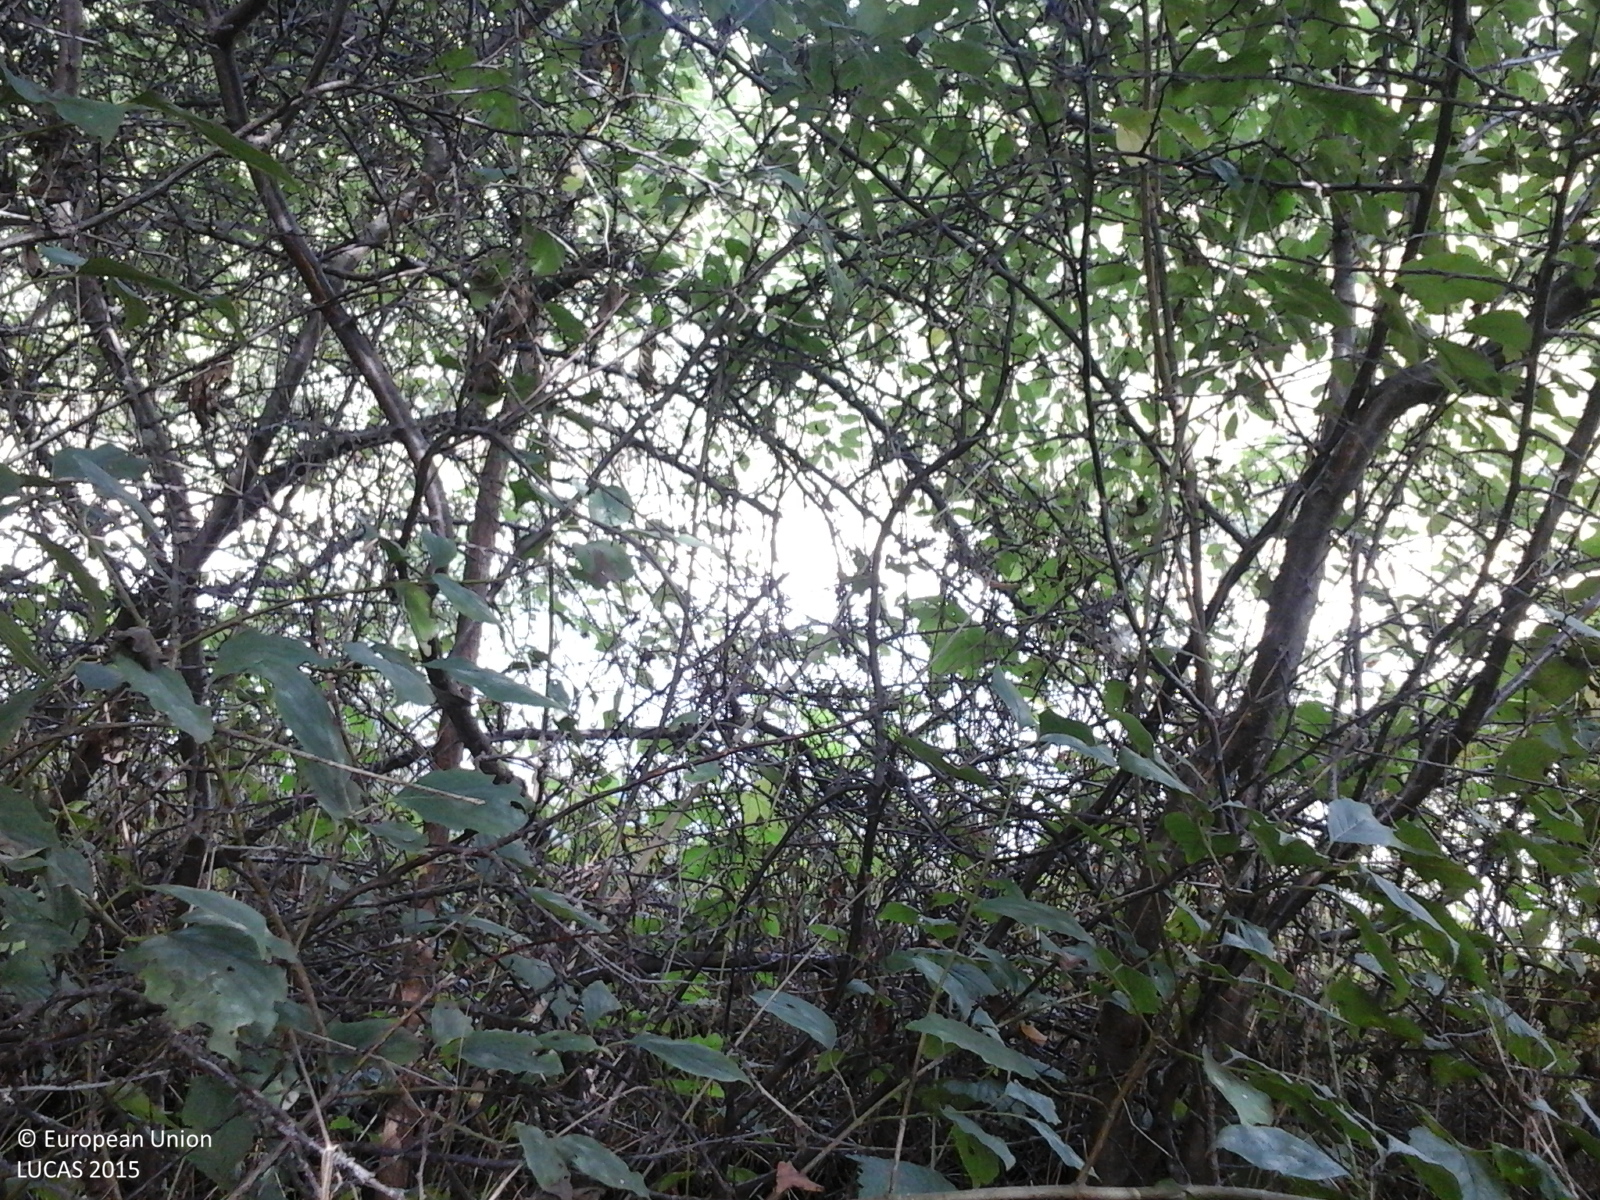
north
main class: Woodland
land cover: Broadleaved woodland
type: exotic forest
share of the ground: > 75 %
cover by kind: broadleaved forest trees 100 %
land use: Forestry
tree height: < 5 m
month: September
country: RO
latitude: 47.1479
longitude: 23.6712
